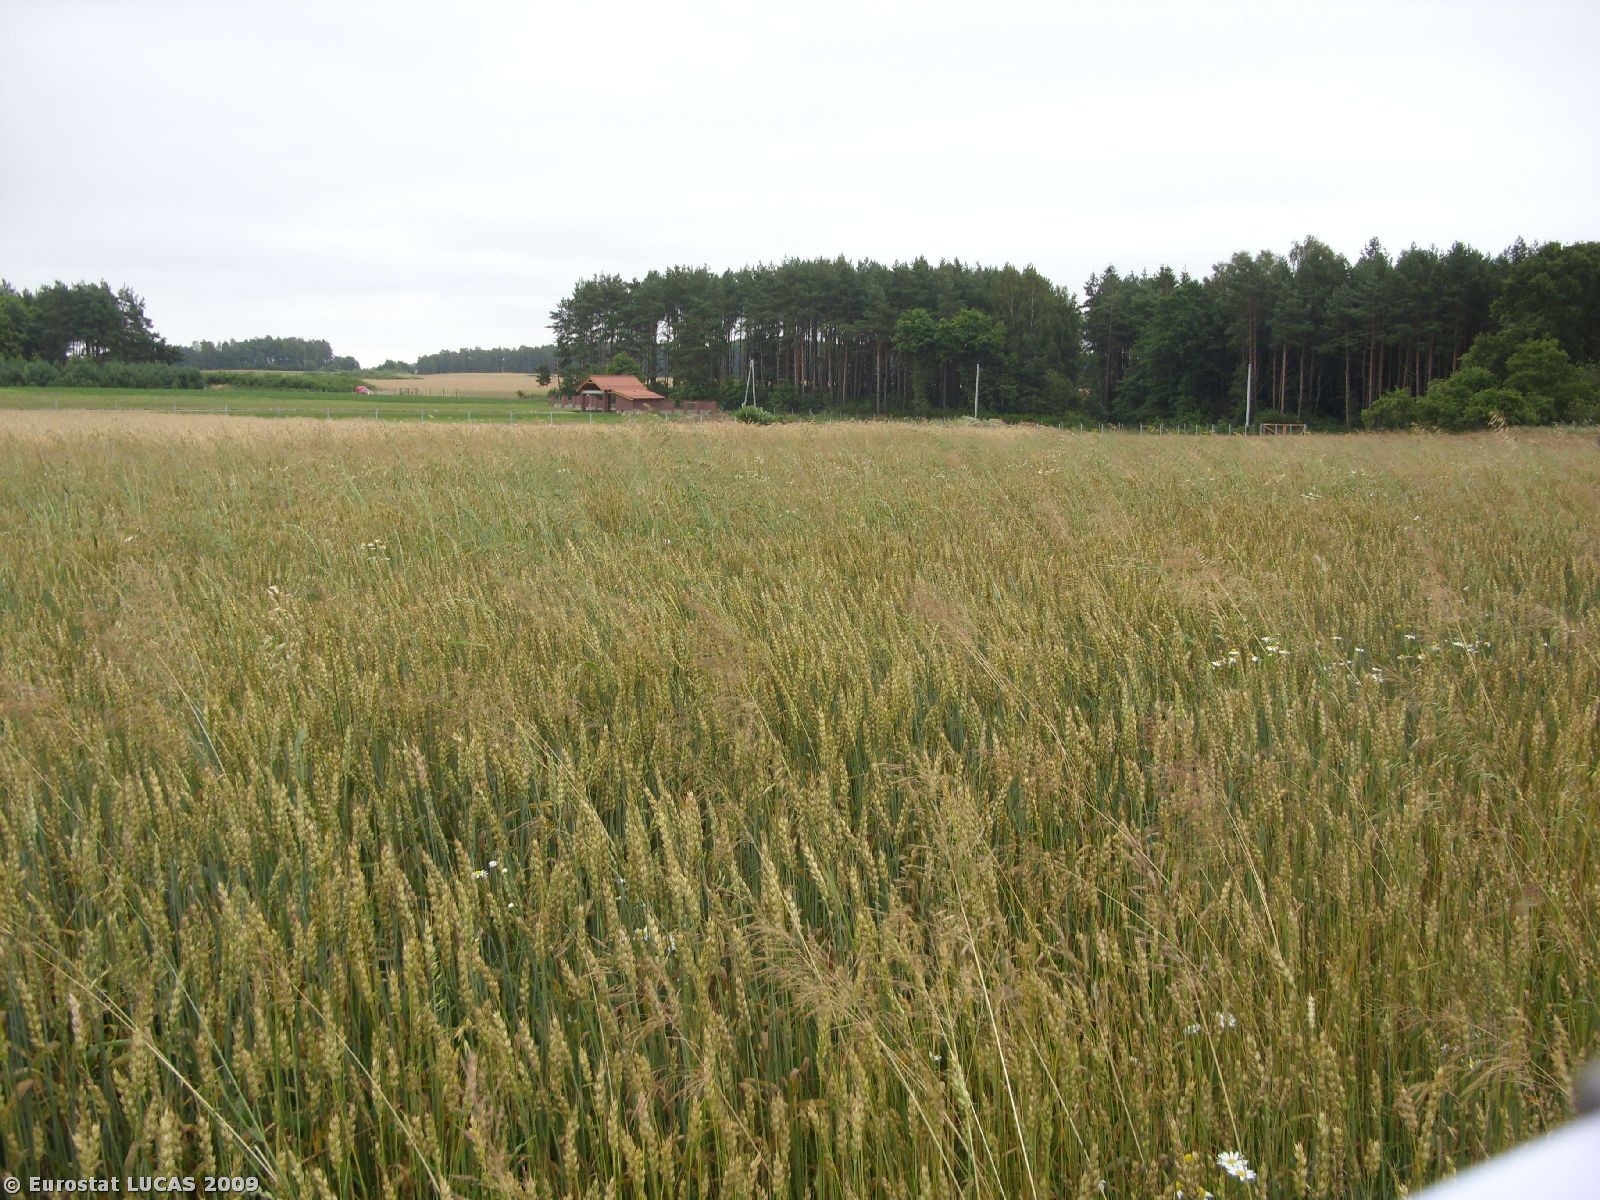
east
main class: Cropland
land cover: Common wheat
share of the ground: > 75 %
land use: Agriculture (excluding fallow land and kitchen gardens)
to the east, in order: Common wheat; Grassland without tree/shrub cover; Fences; Grassland without tree/shrub cover; Lines of trees; Spontaneously vegetated surfaces
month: July
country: PL
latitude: 54.0662
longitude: 15.5802
